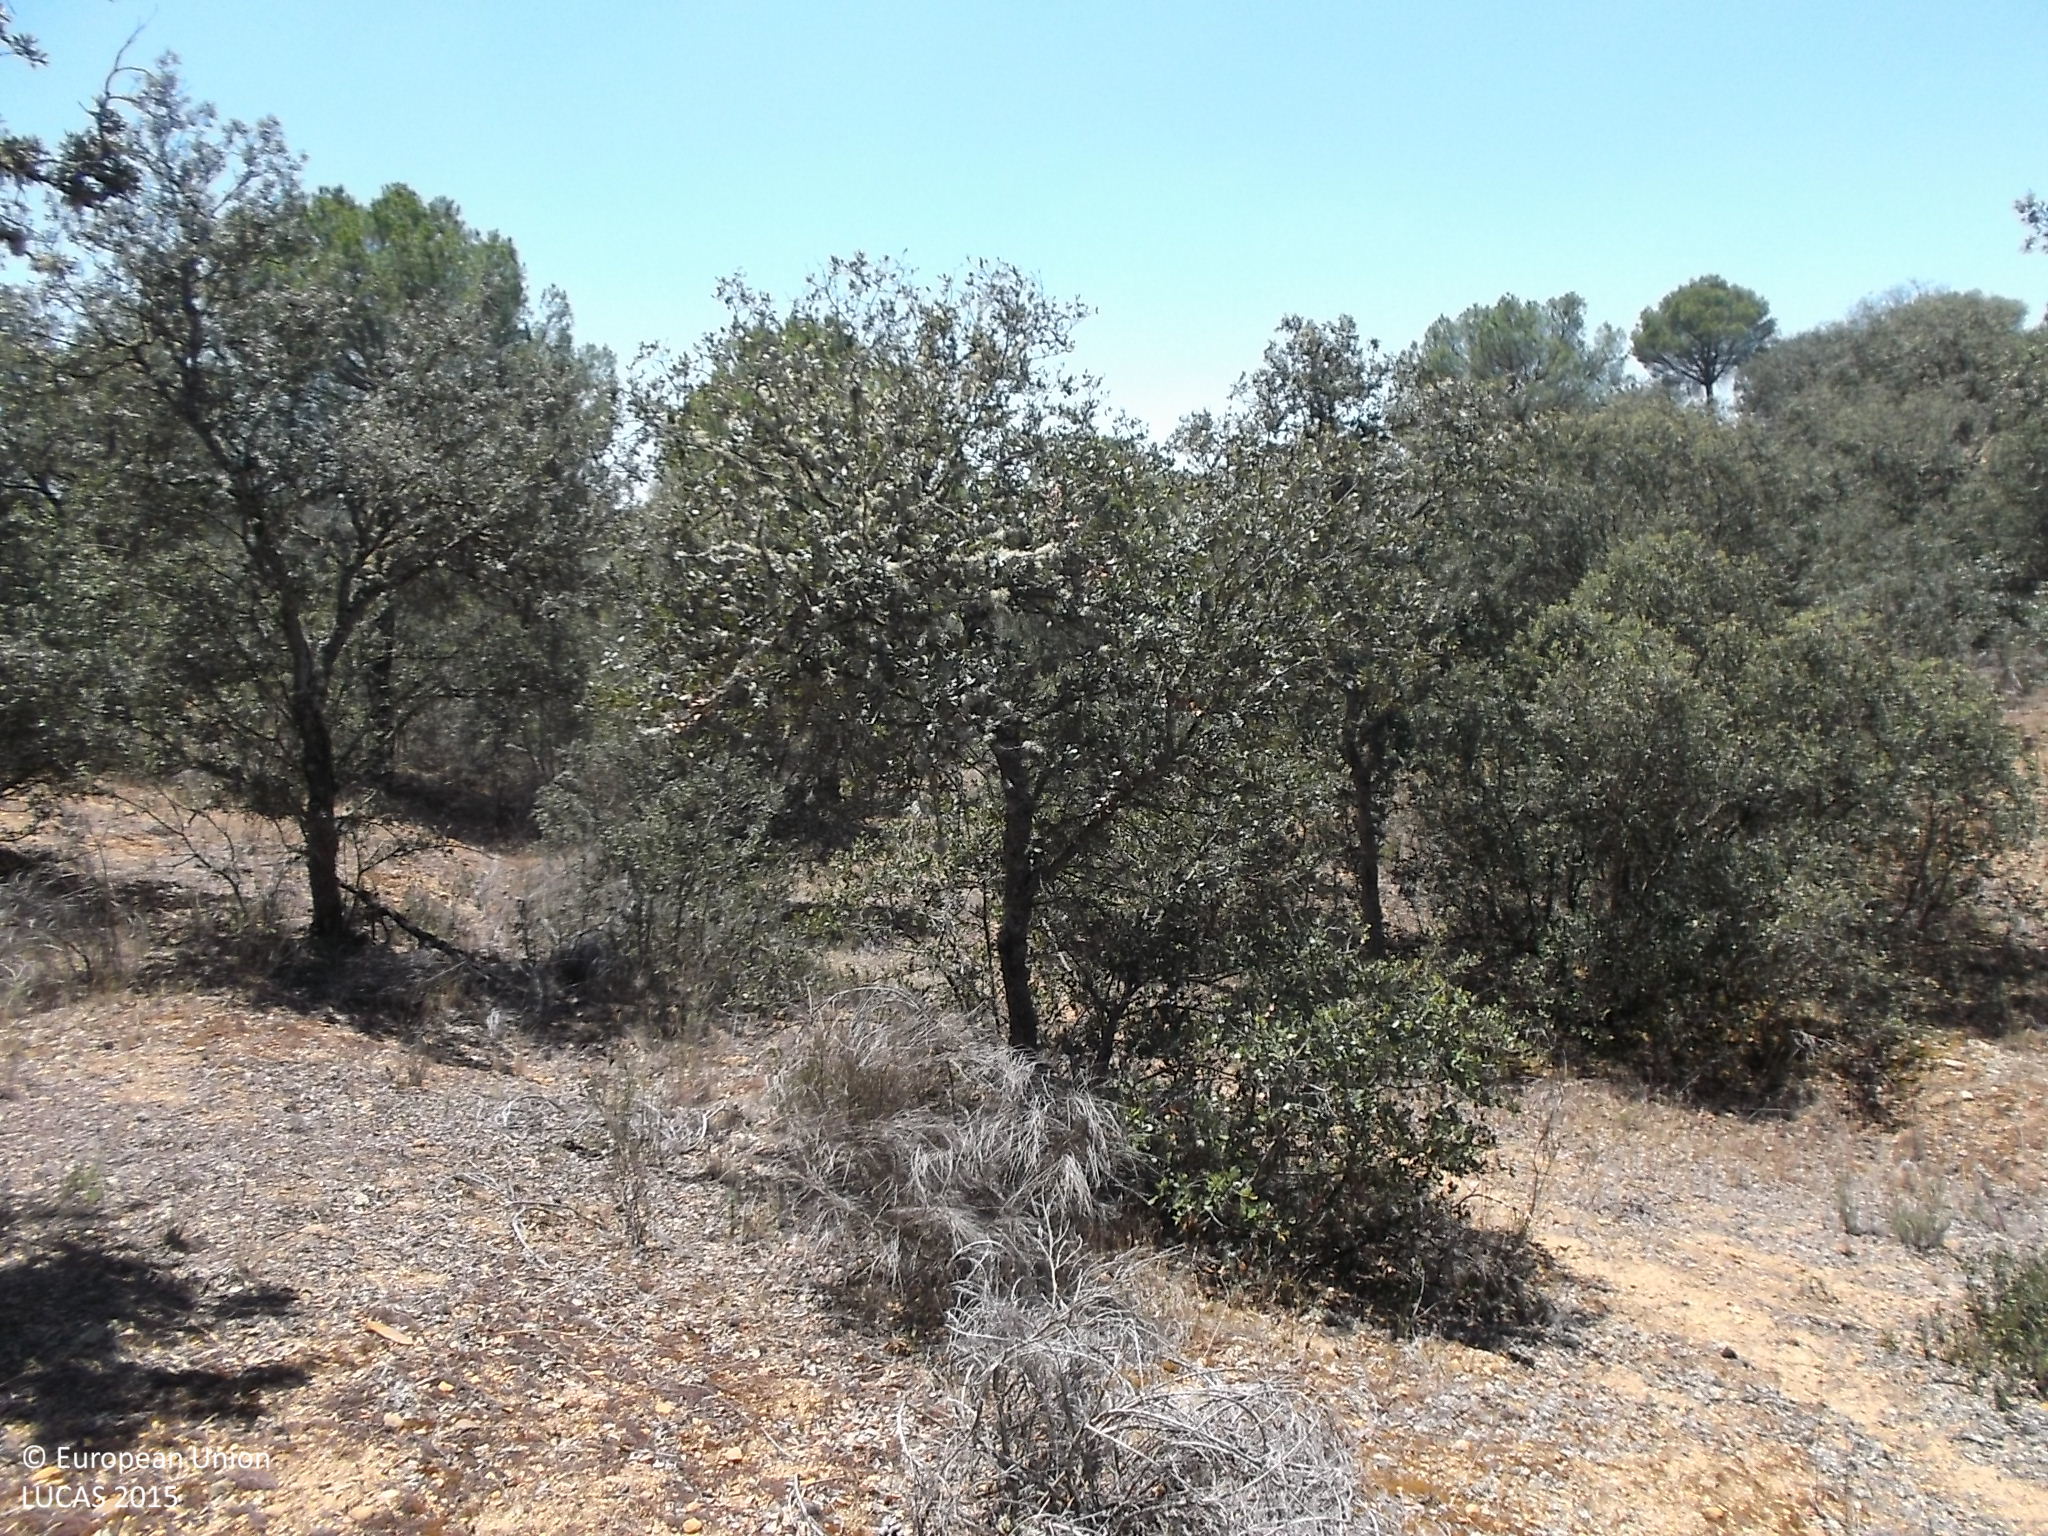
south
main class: Woodland
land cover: Other mixed woodland
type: coniferous forest of the mediterranean region
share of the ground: 50 - 75 %
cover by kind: coniferous forest trees 50 %, broadleaved forest trees 20 %, shrubs 20 %, herbaceous plants 10 %
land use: Forestry
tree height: > 5 m
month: June
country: ES
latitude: 41.4154
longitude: -5.5019
